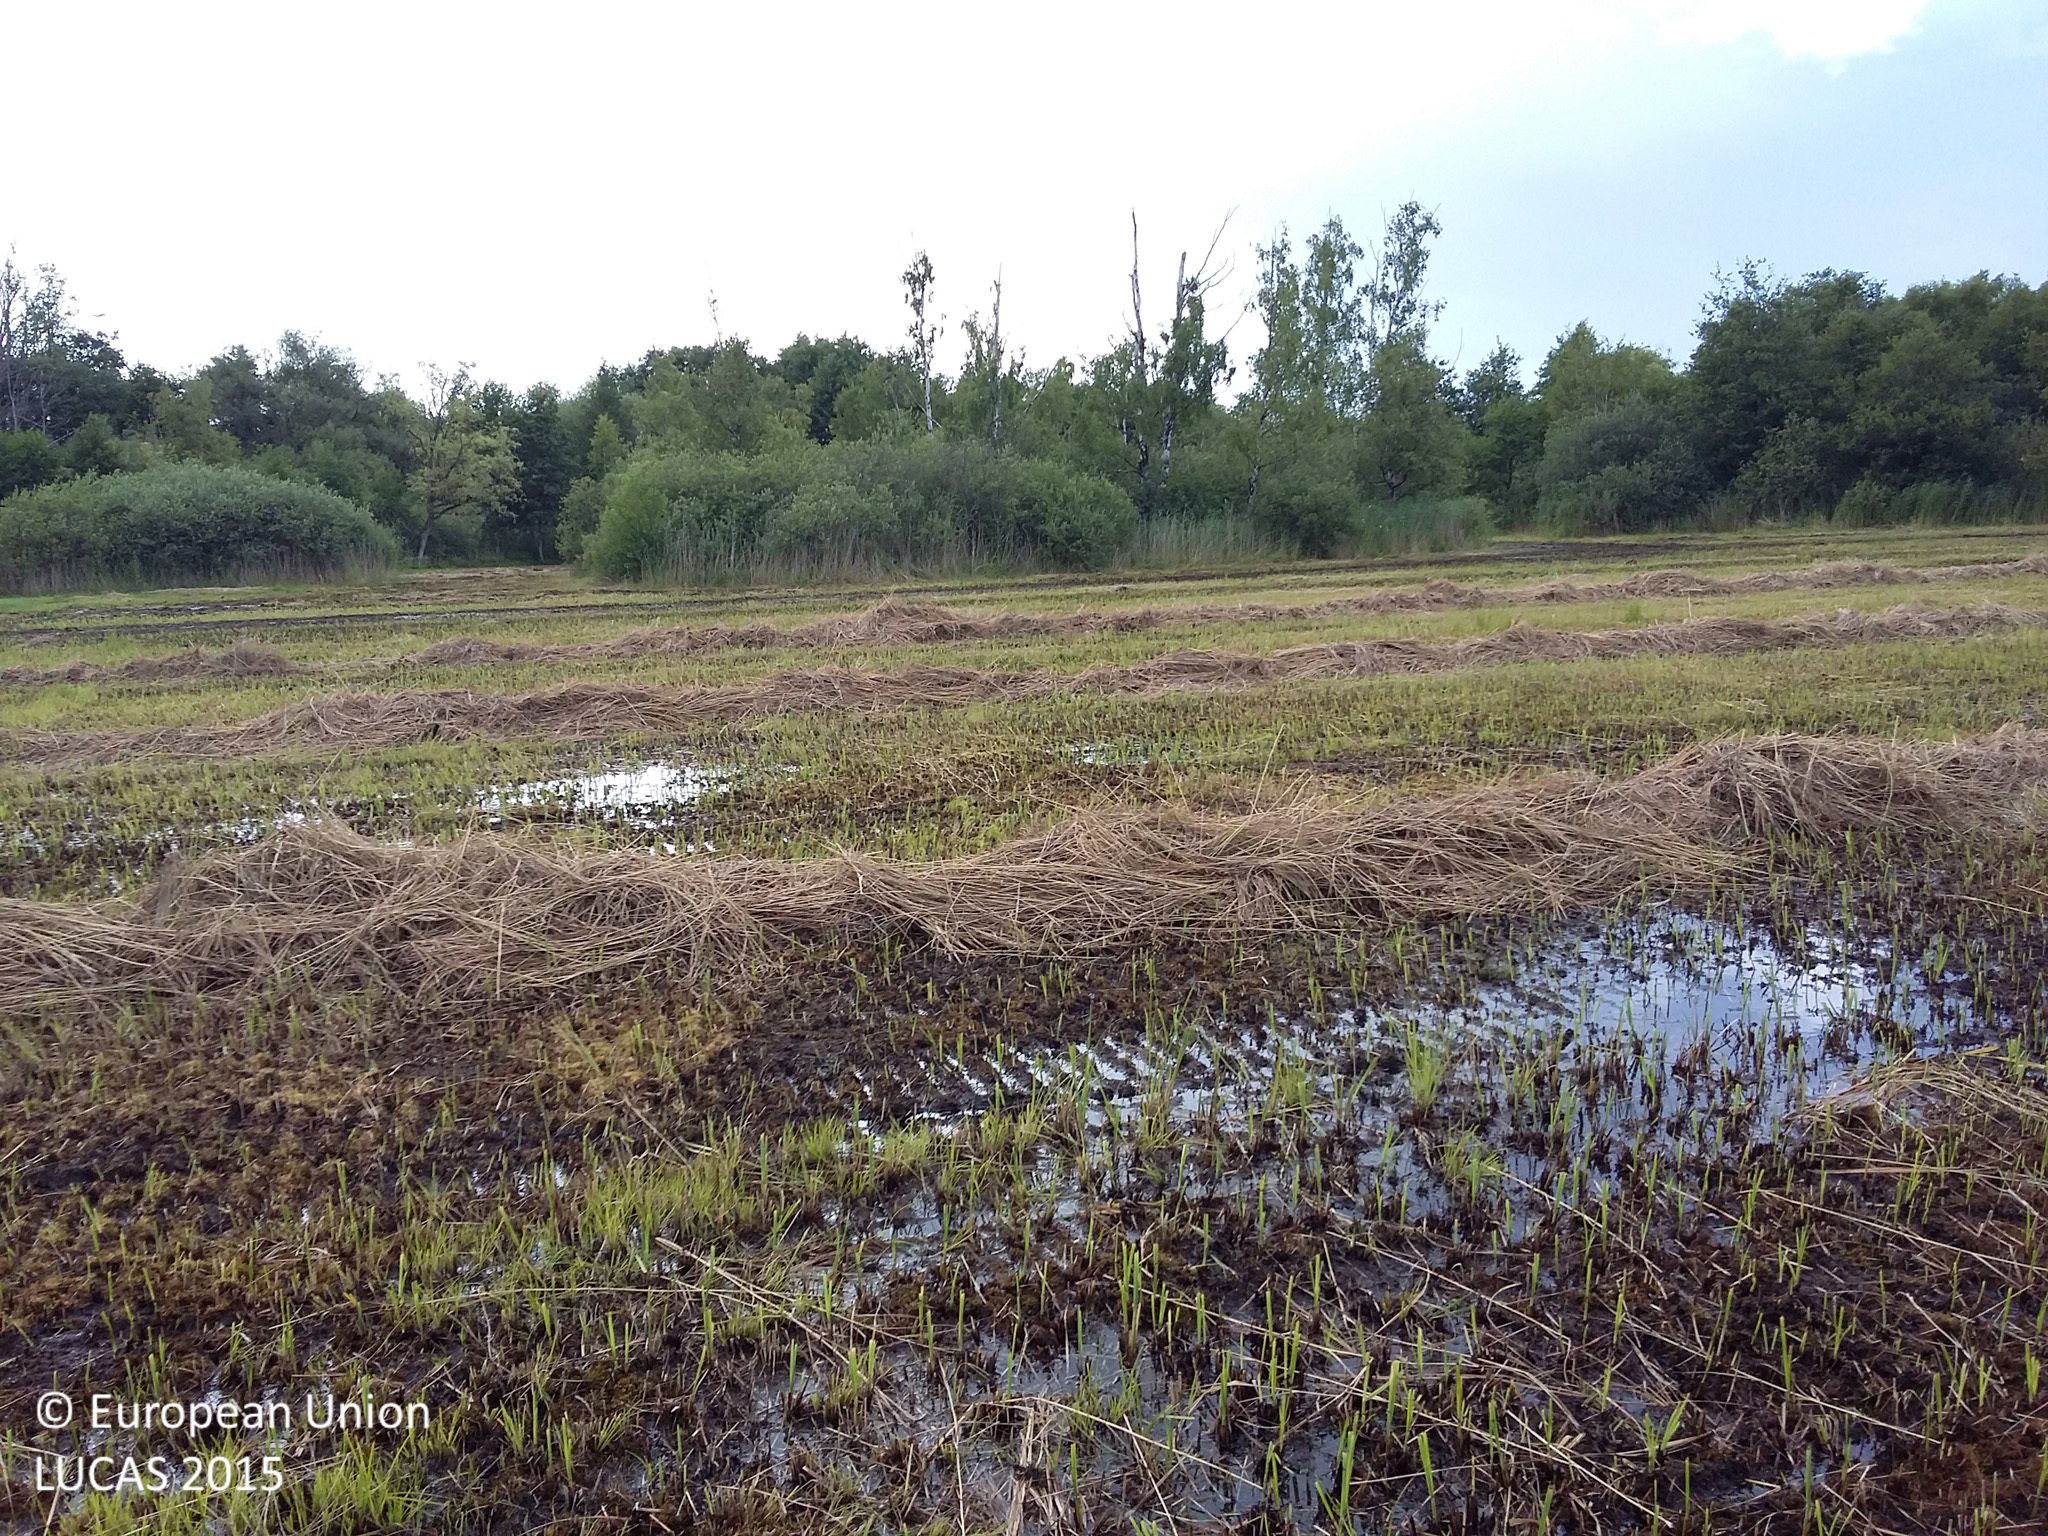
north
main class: Cropland
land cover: Permanent industrial crops
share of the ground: 10 - 25 %
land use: Agriculture (excluding fallow land and kitchen gardens)
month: July
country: DK
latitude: 55.7492
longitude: 12.5311
